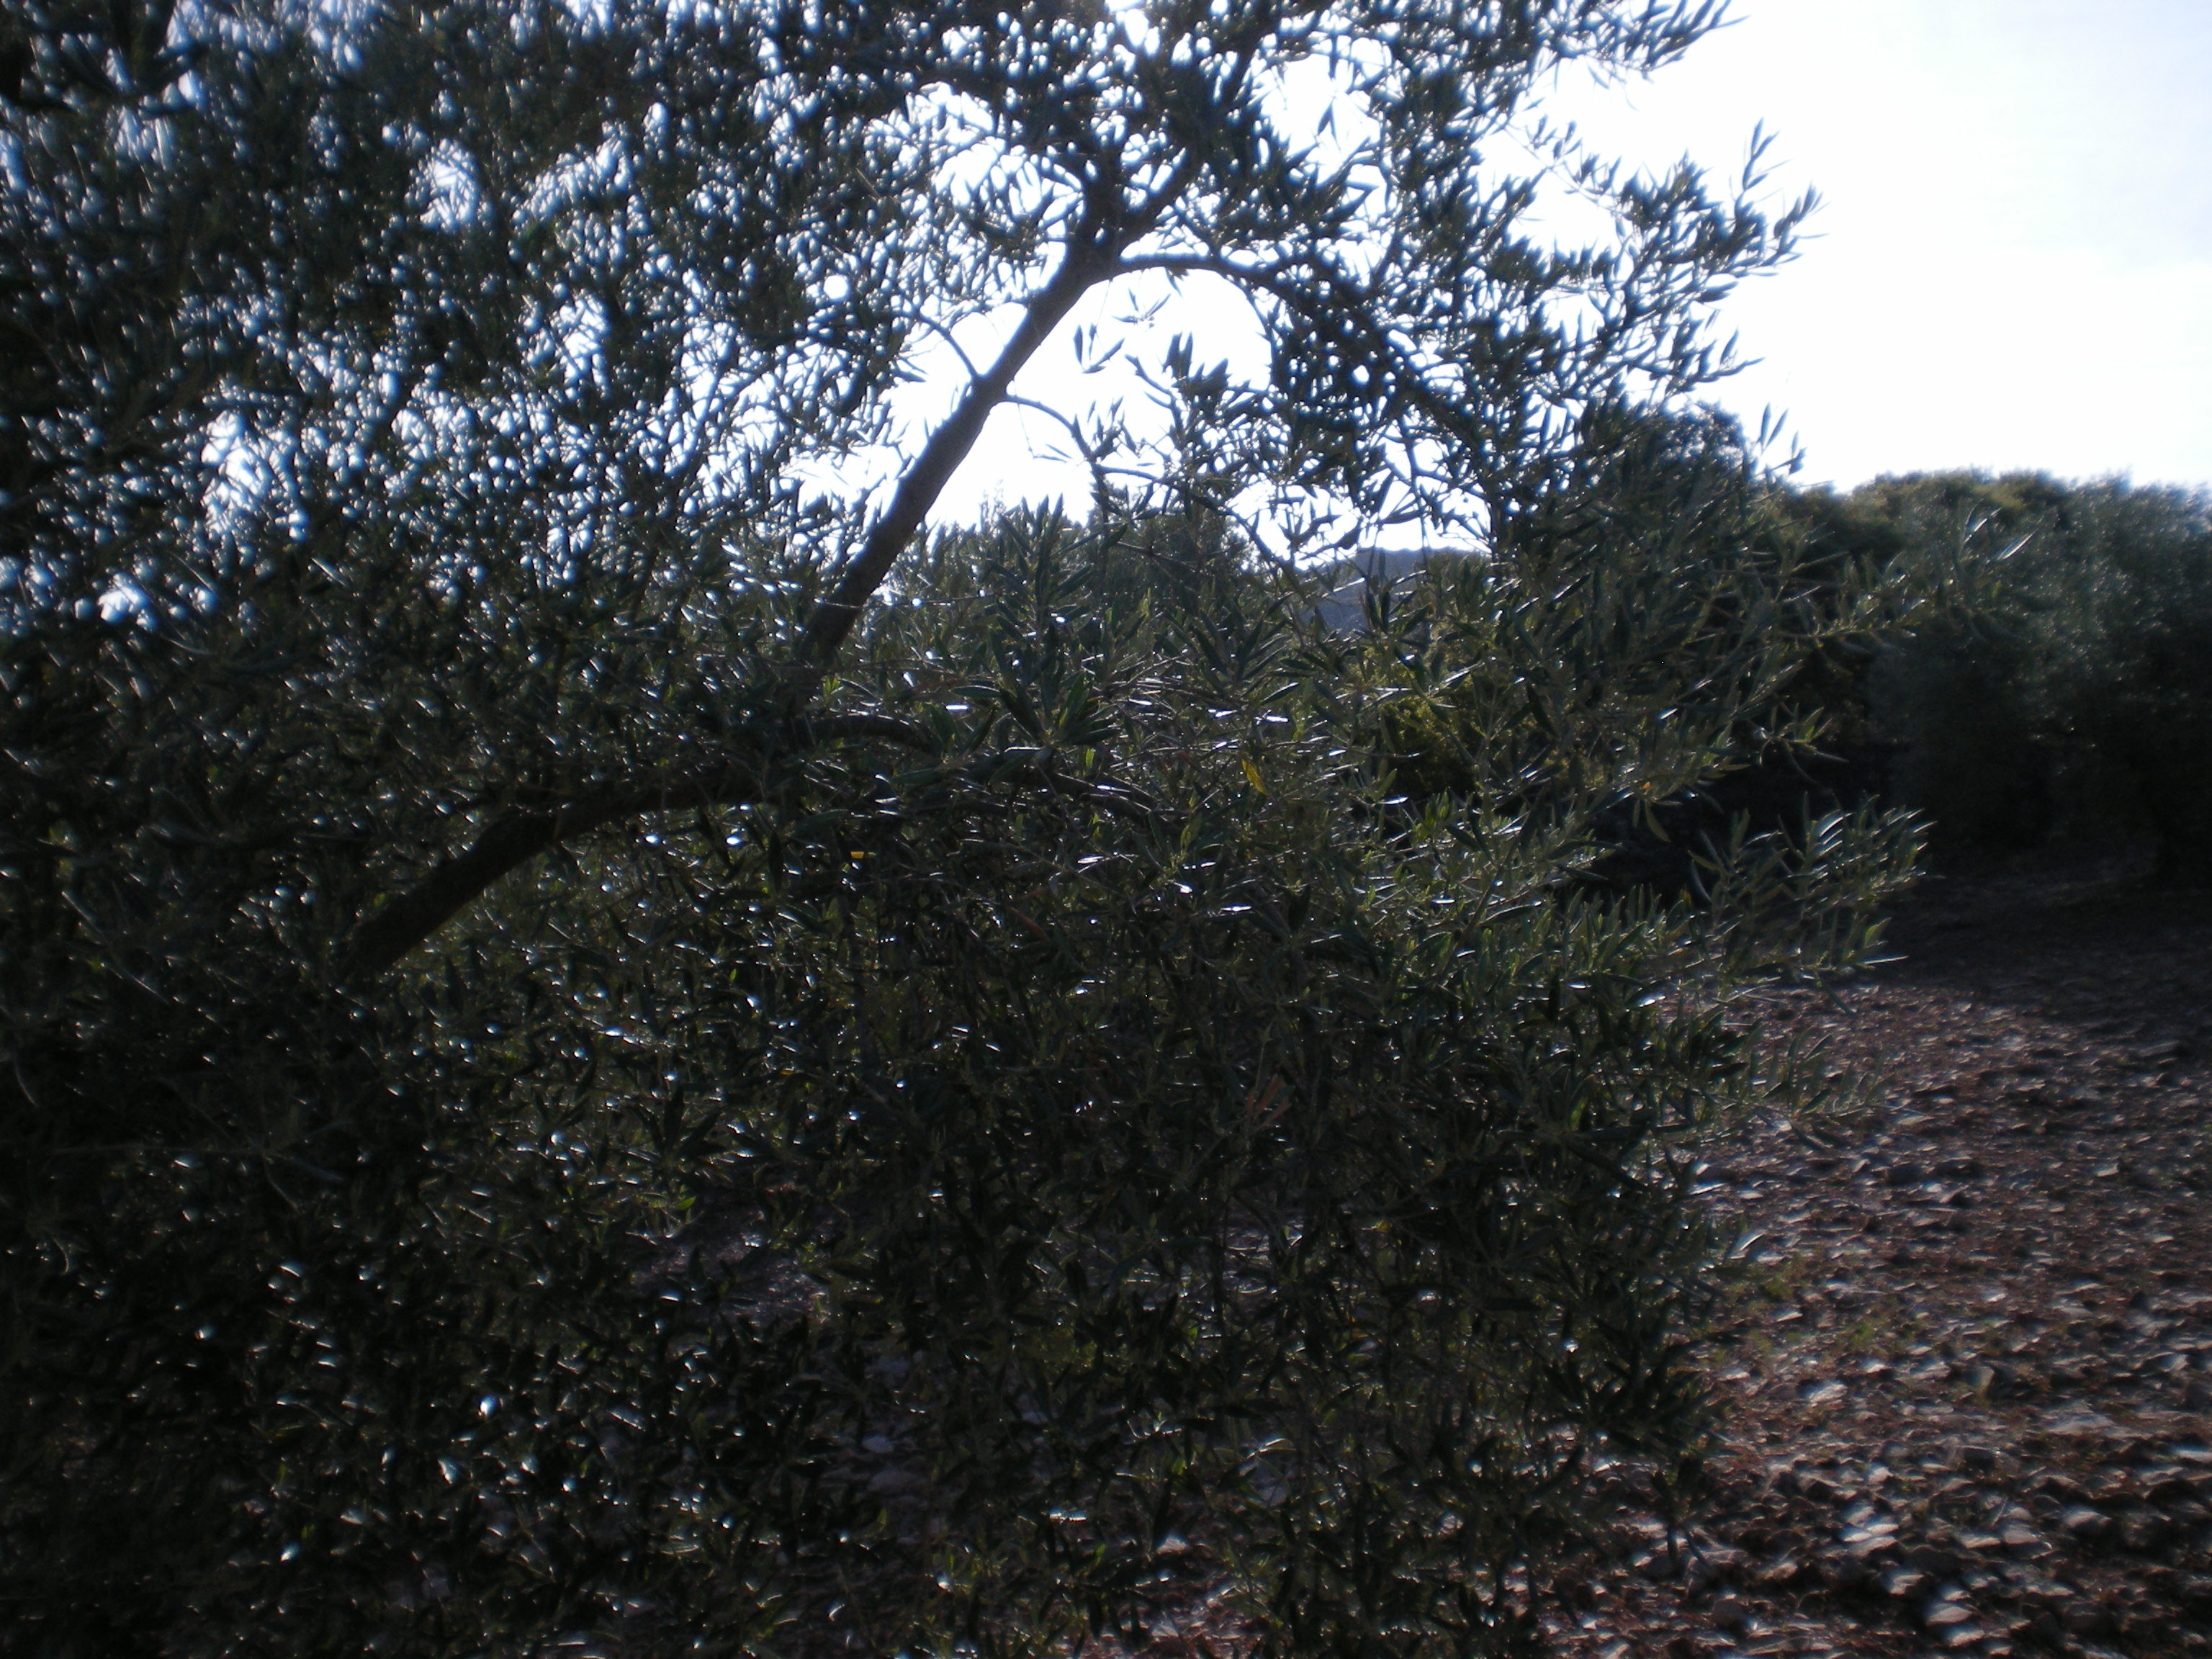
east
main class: Cropland
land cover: Olive groves
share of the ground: 25 - 50 %
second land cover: Other bare soil
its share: > 75 %
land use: Agriculture (excluding fallow land and kitchen gardens)
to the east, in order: Olive groves; Other bare soil; Dry stone walls; Abandoned hedges; Olive groves; Dry stone walls; Abandoned hedges; Olive groves; Dry stone walls; Abandoned hedges; Olive groves; Dry stone walls; Abandoned hedges; Olive groves; Dry stone walls; Abandoned hedges; Tracks; Grass margins; Grassland without tree/shrub cover; Fences; Grassland without tree/shrub cover
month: April
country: ES
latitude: 38.5374
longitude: -3.0021
